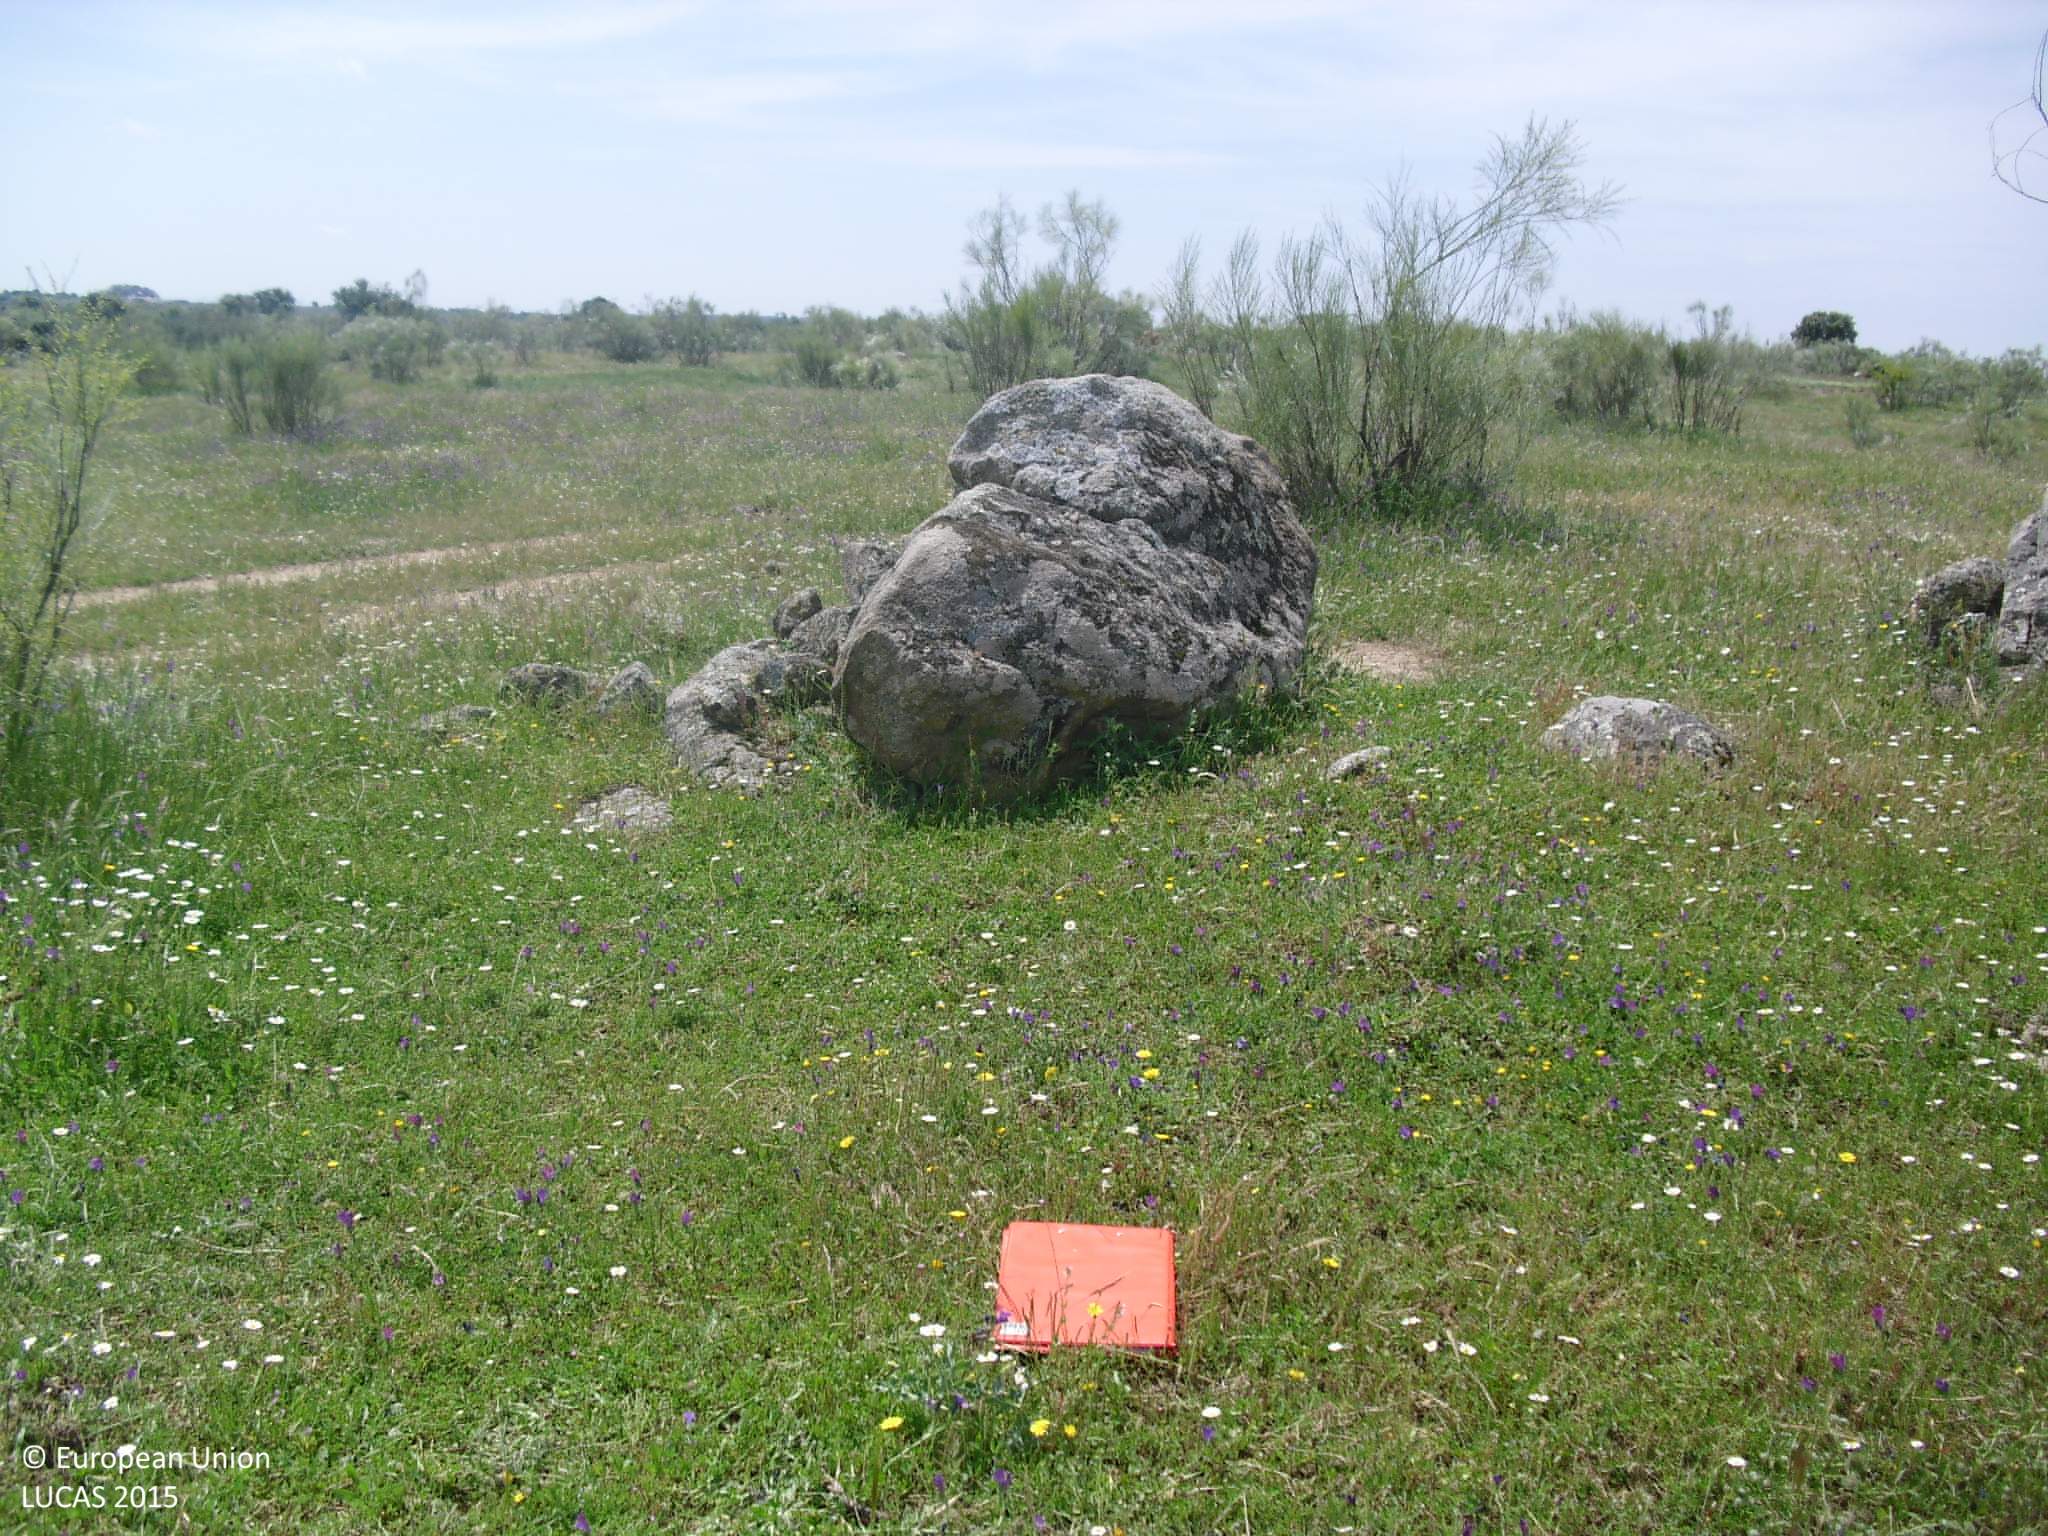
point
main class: Shrubland
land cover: Shrubland without tree cover
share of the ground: 10 - 25 %
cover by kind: herbaceous plants 85 %, shrubs 10 %, unconsolidated bare surface 5 %
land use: Agriculture (excluding fallow land and kitchen gardens)
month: May
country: ES
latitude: 39.3142
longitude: -5.7692
